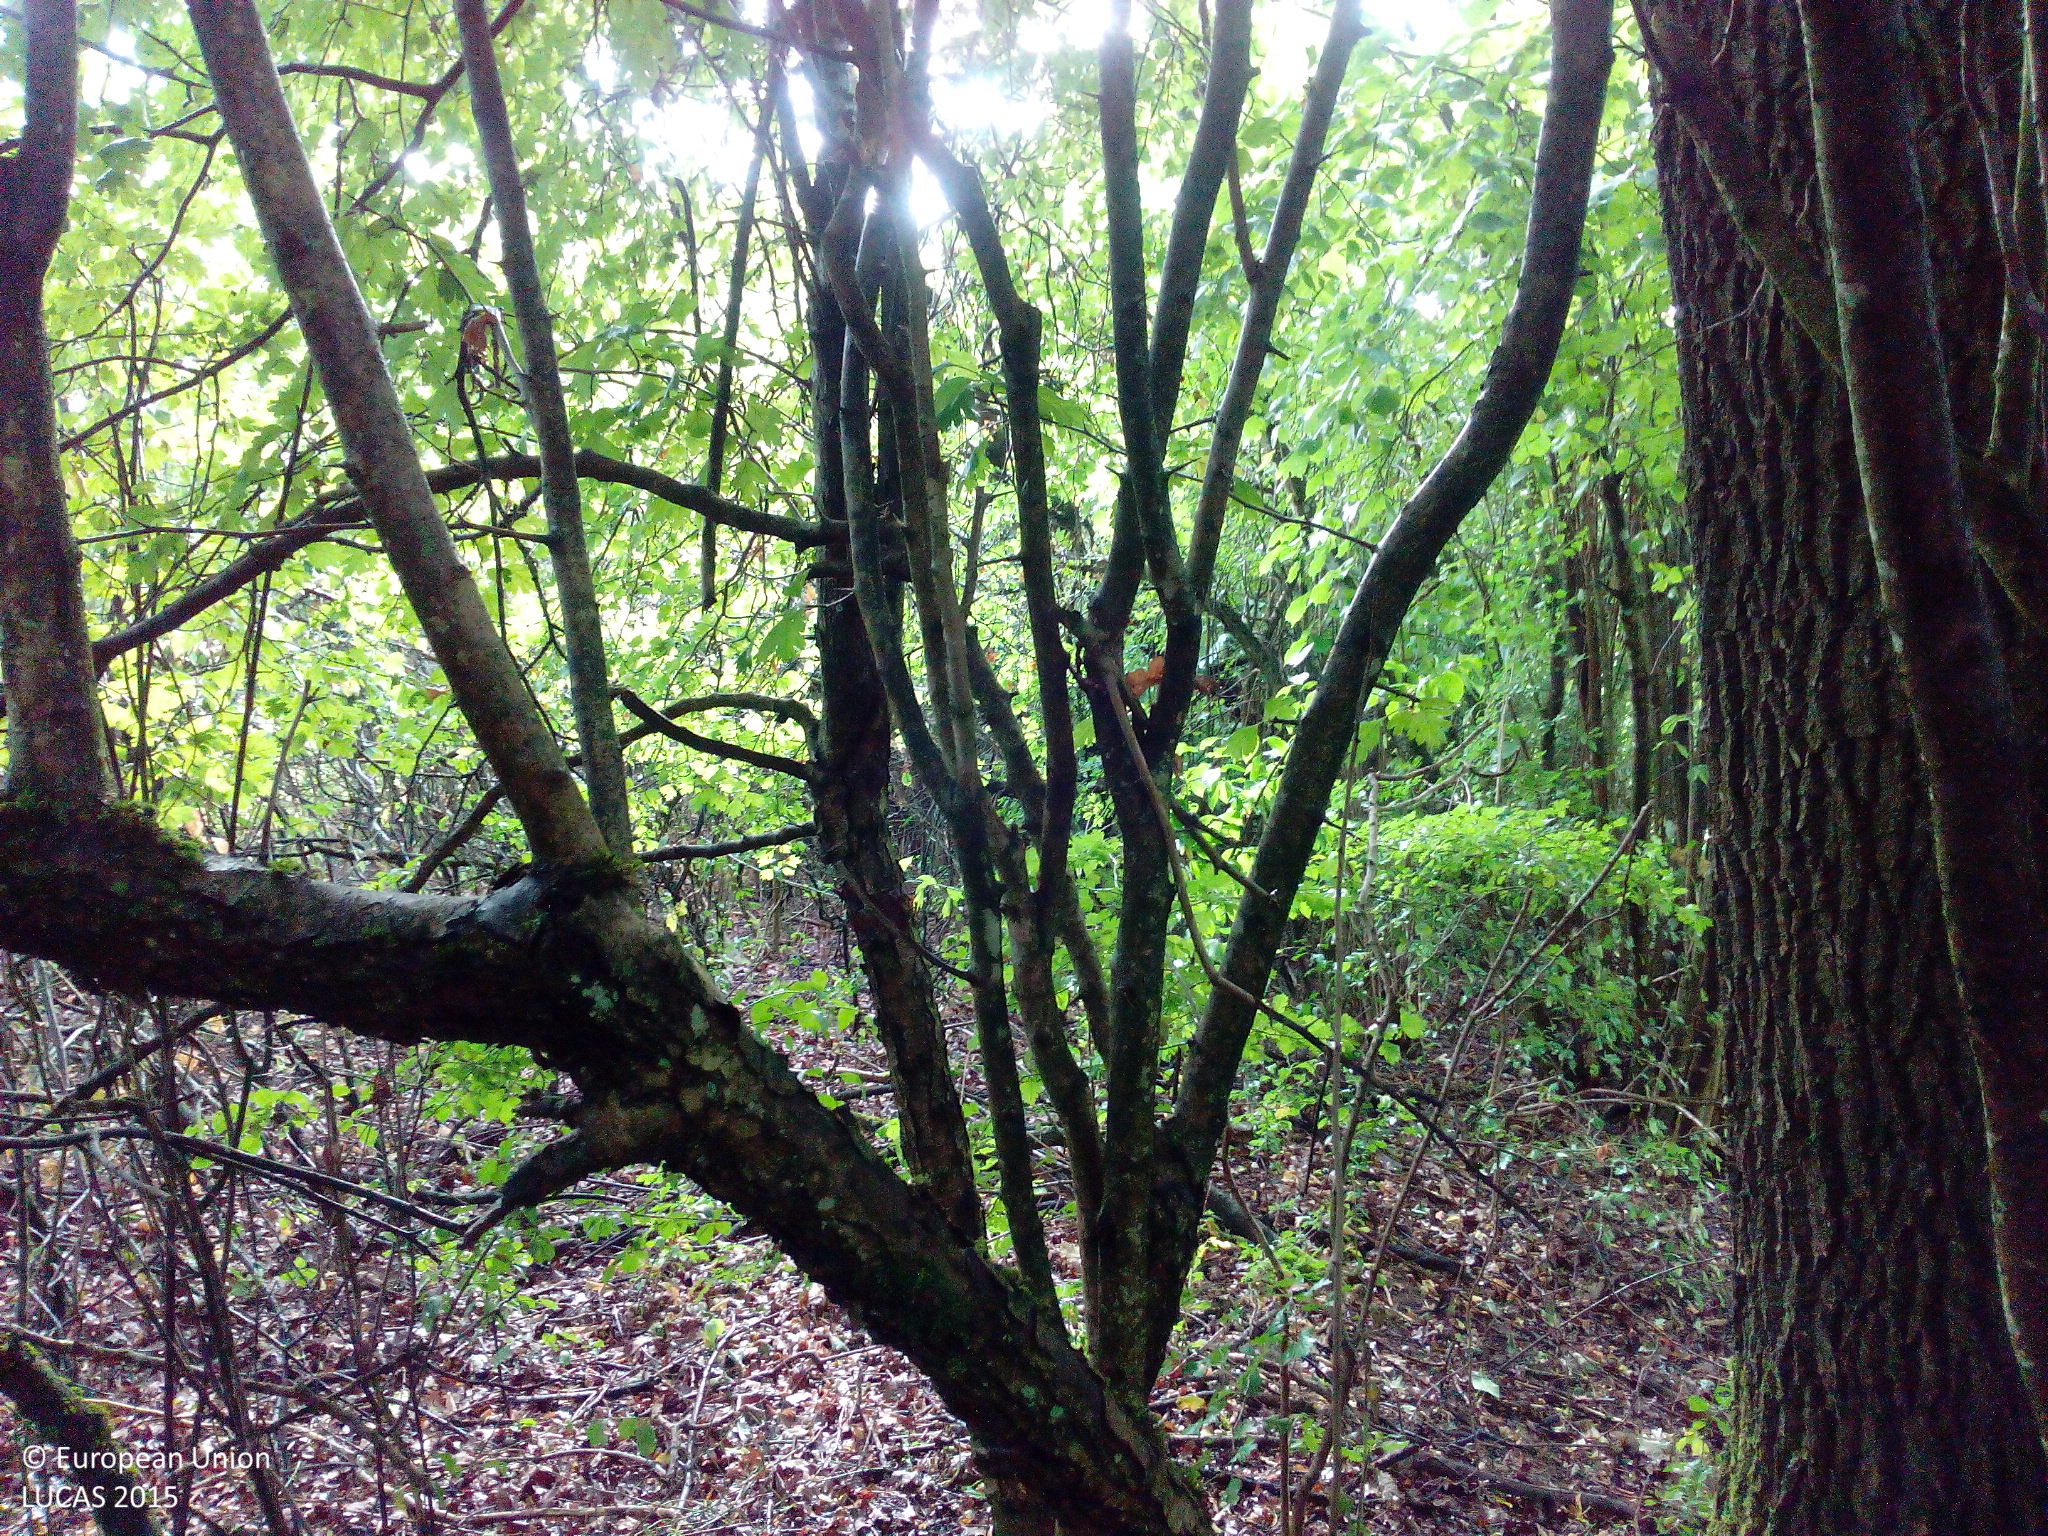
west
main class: Woodland
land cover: Broadleaved woodland
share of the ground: > 75 %
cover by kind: broadleaved forest trees 90 %, shrubs 10 %
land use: Semi-natural and natural areas not in use
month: July
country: DE
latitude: 49.0147
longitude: 9.6857
